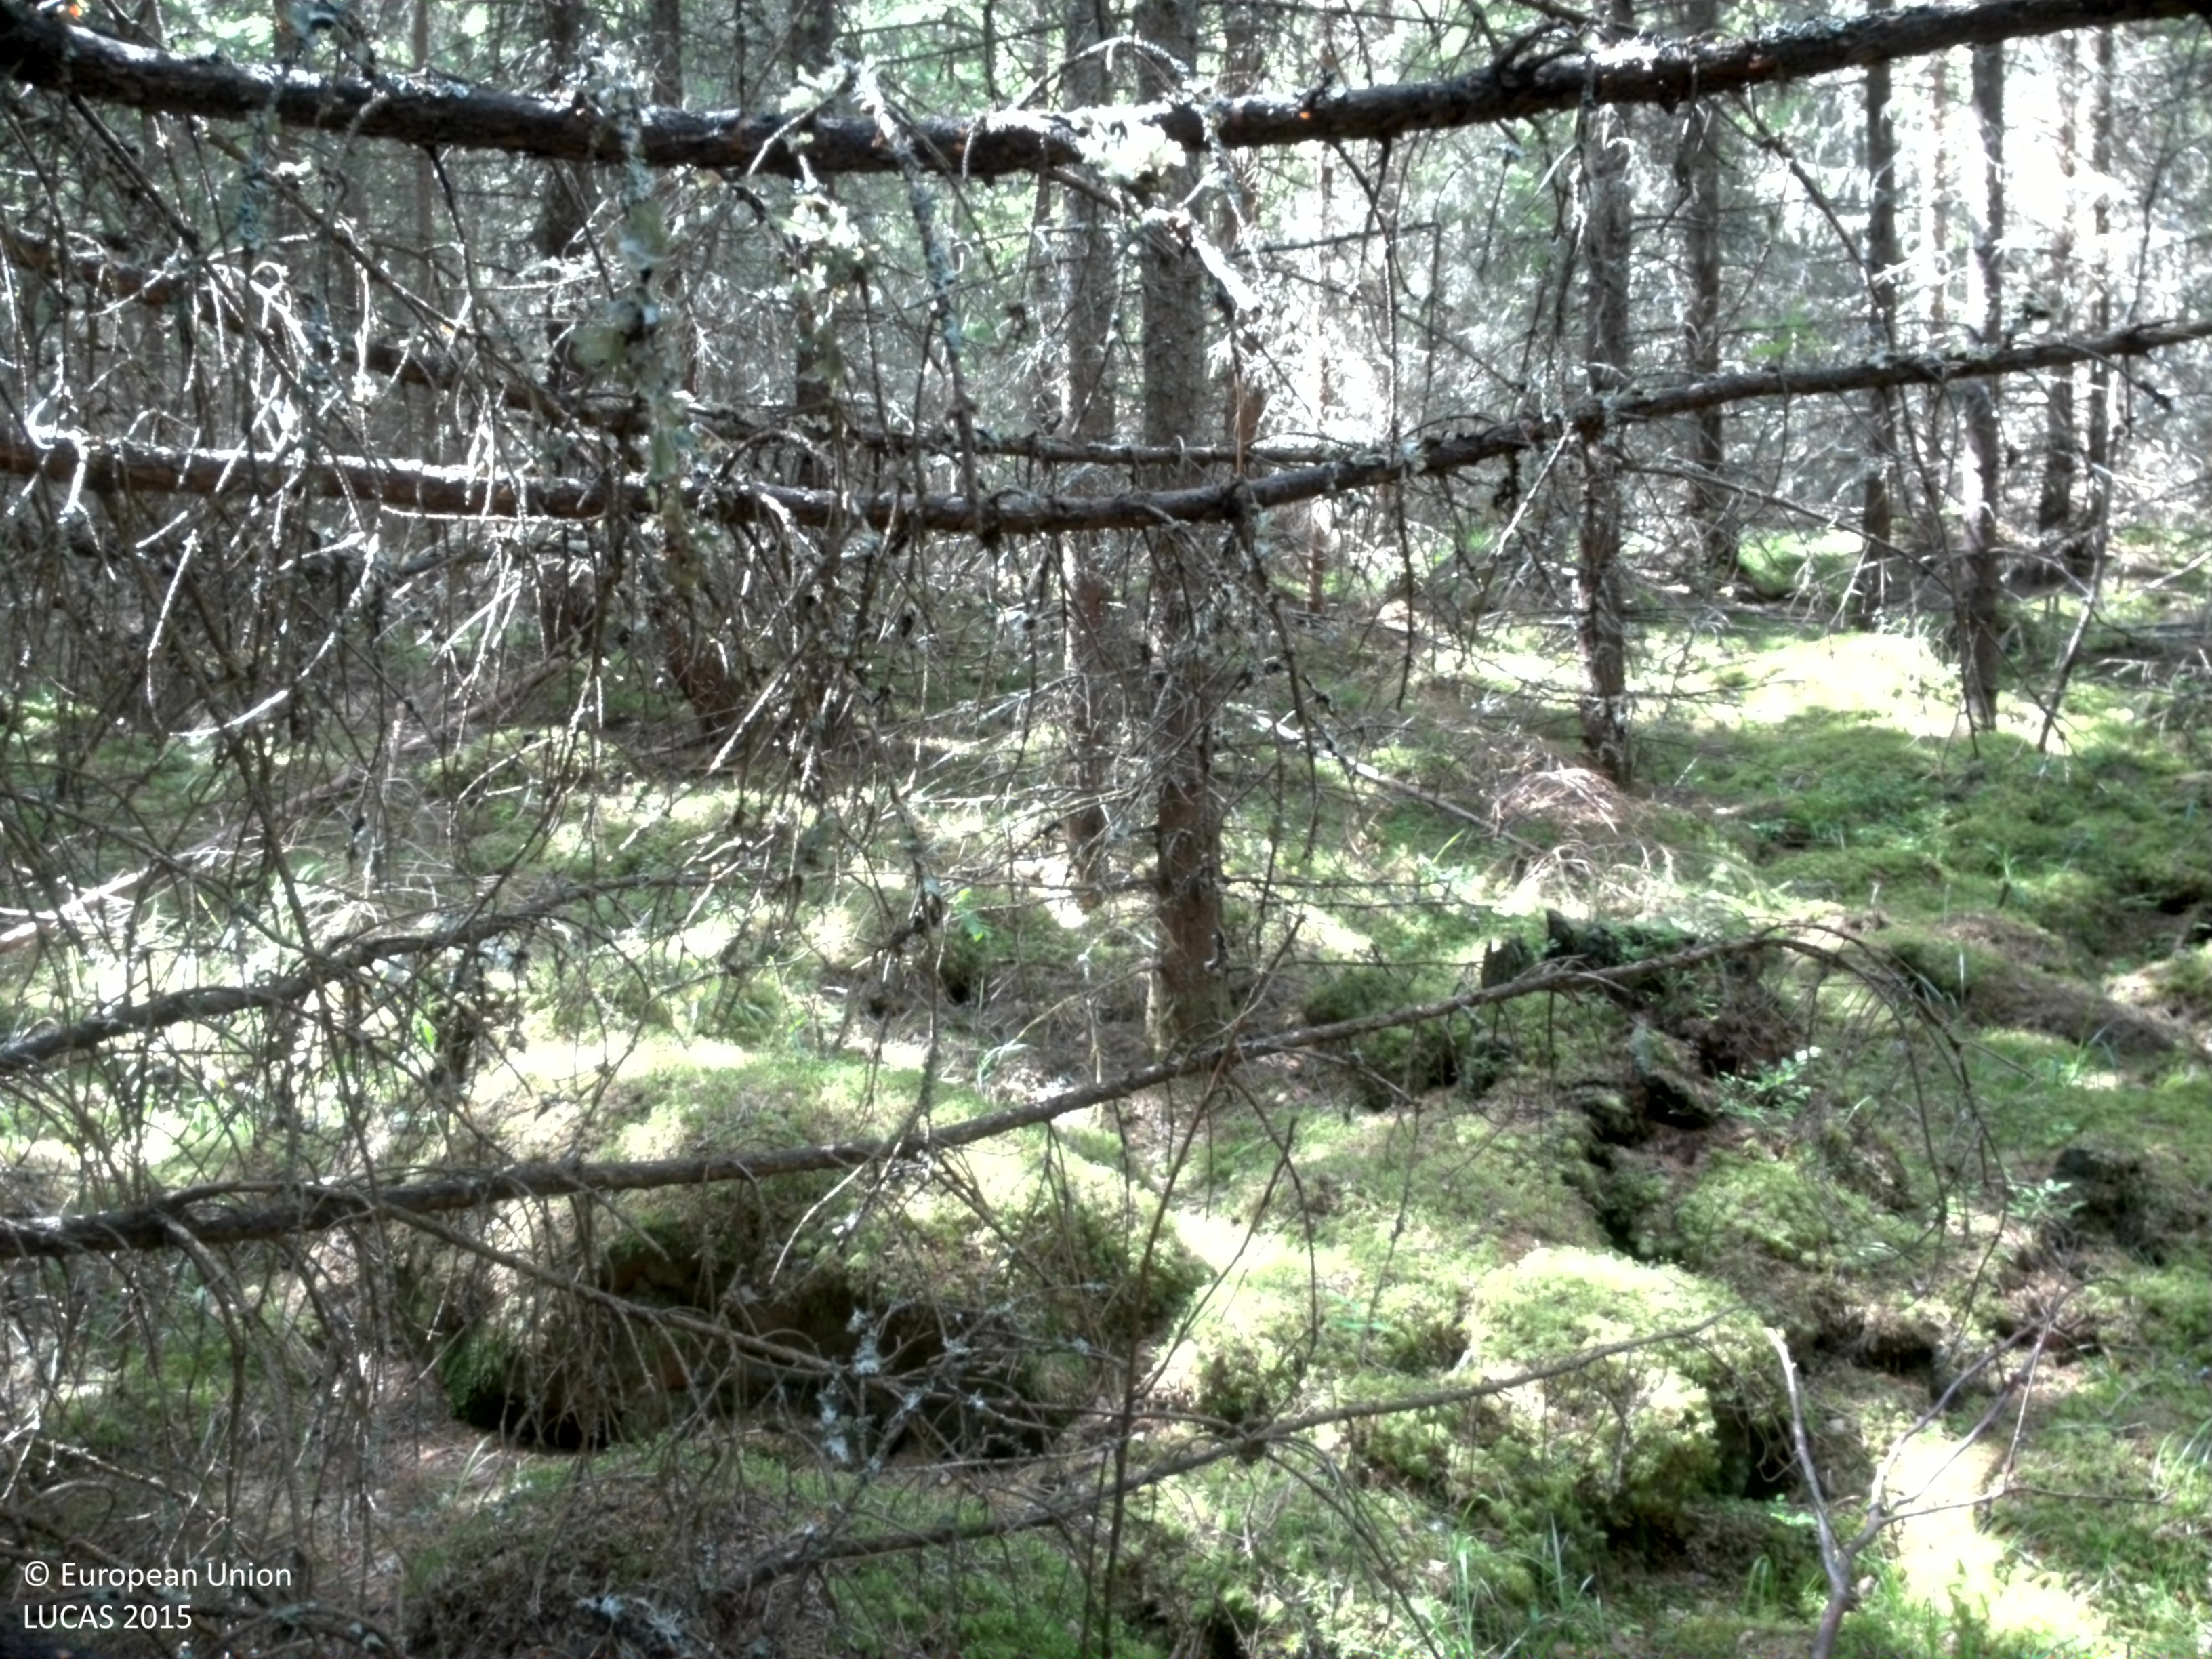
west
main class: Woodland
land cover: Spruce dominated coniferous woodland
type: boreal forest
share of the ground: > 75 %
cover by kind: coniferous forest trees 85 %, lichens and mosses 15 %
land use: Forestry
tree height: > 5 m
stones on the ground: > 50 %
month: July
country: SE
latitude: 59.6159
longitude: 14.6877
